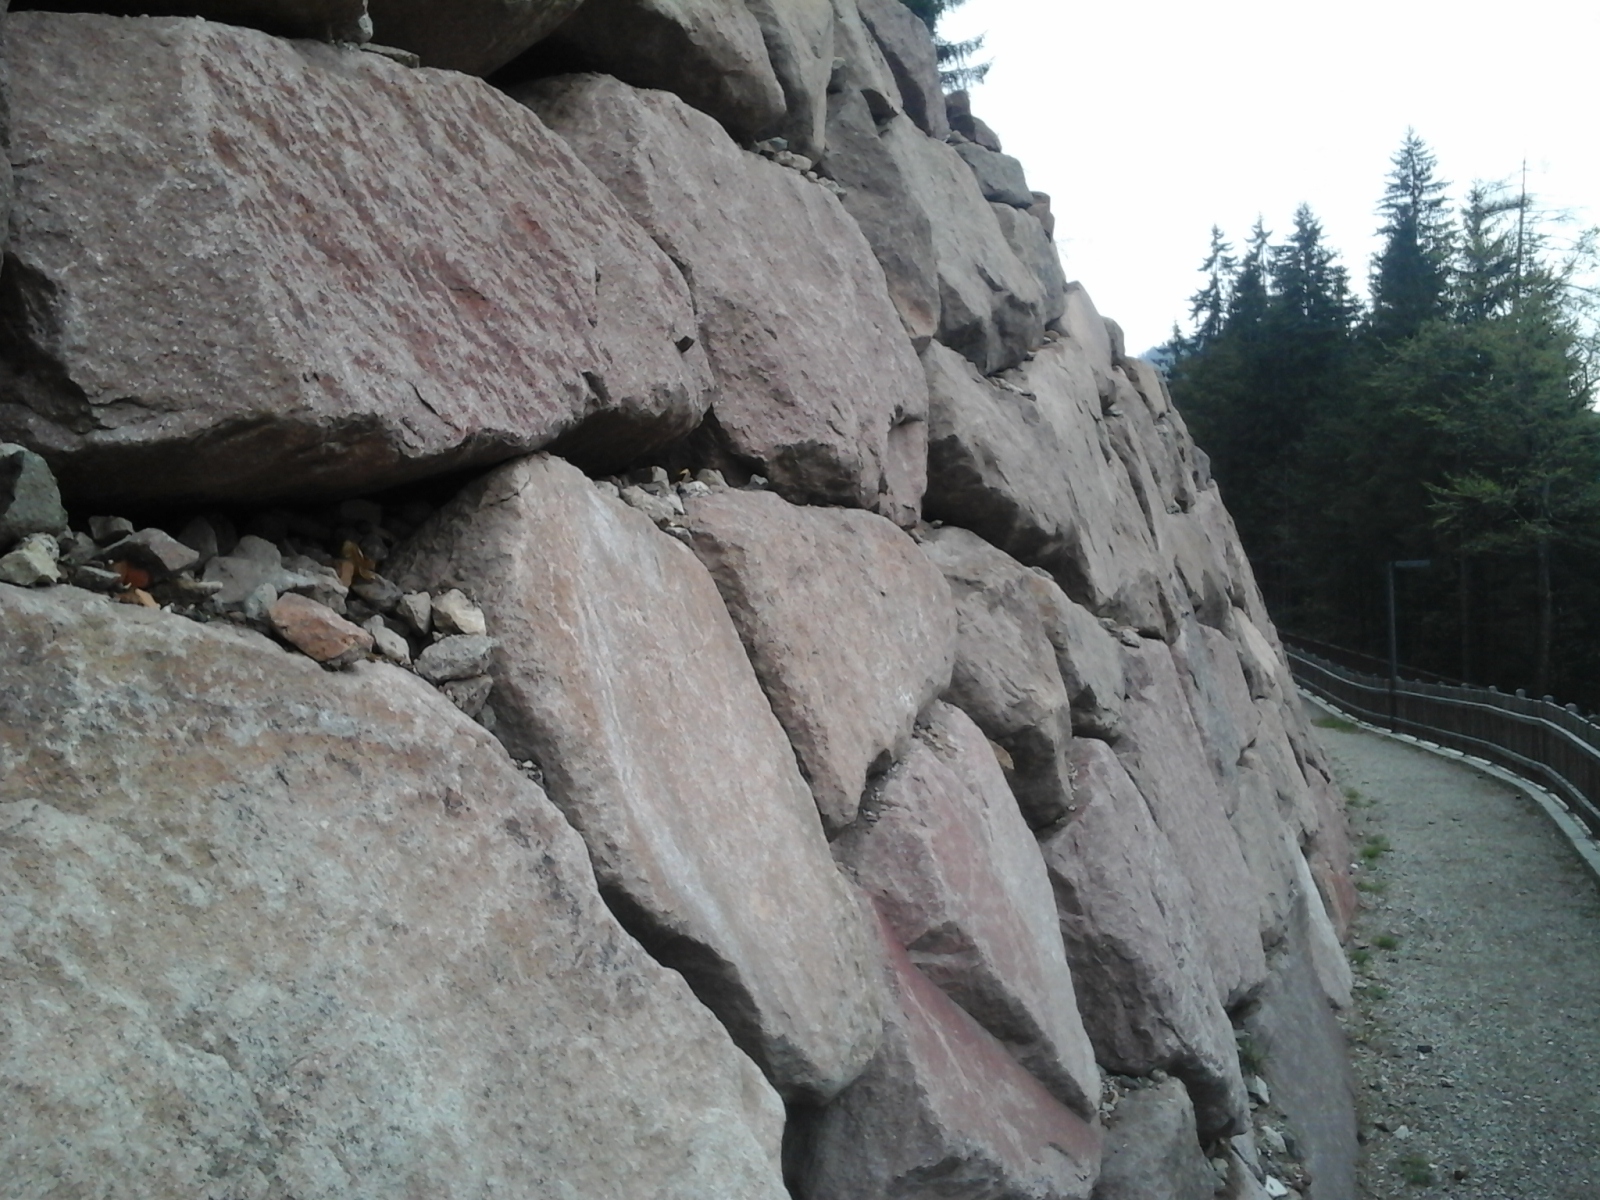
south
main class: Woodland
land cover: Spruce dominated coniferous woodland
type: alpine coniferous forest
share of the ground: > 75 %
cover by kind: coniferous forest trees 95 %, herbaceous plants 5 %
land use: Forestry
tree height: > 5 m
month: May
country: IT
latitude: 46.4301
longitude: 11.5467
